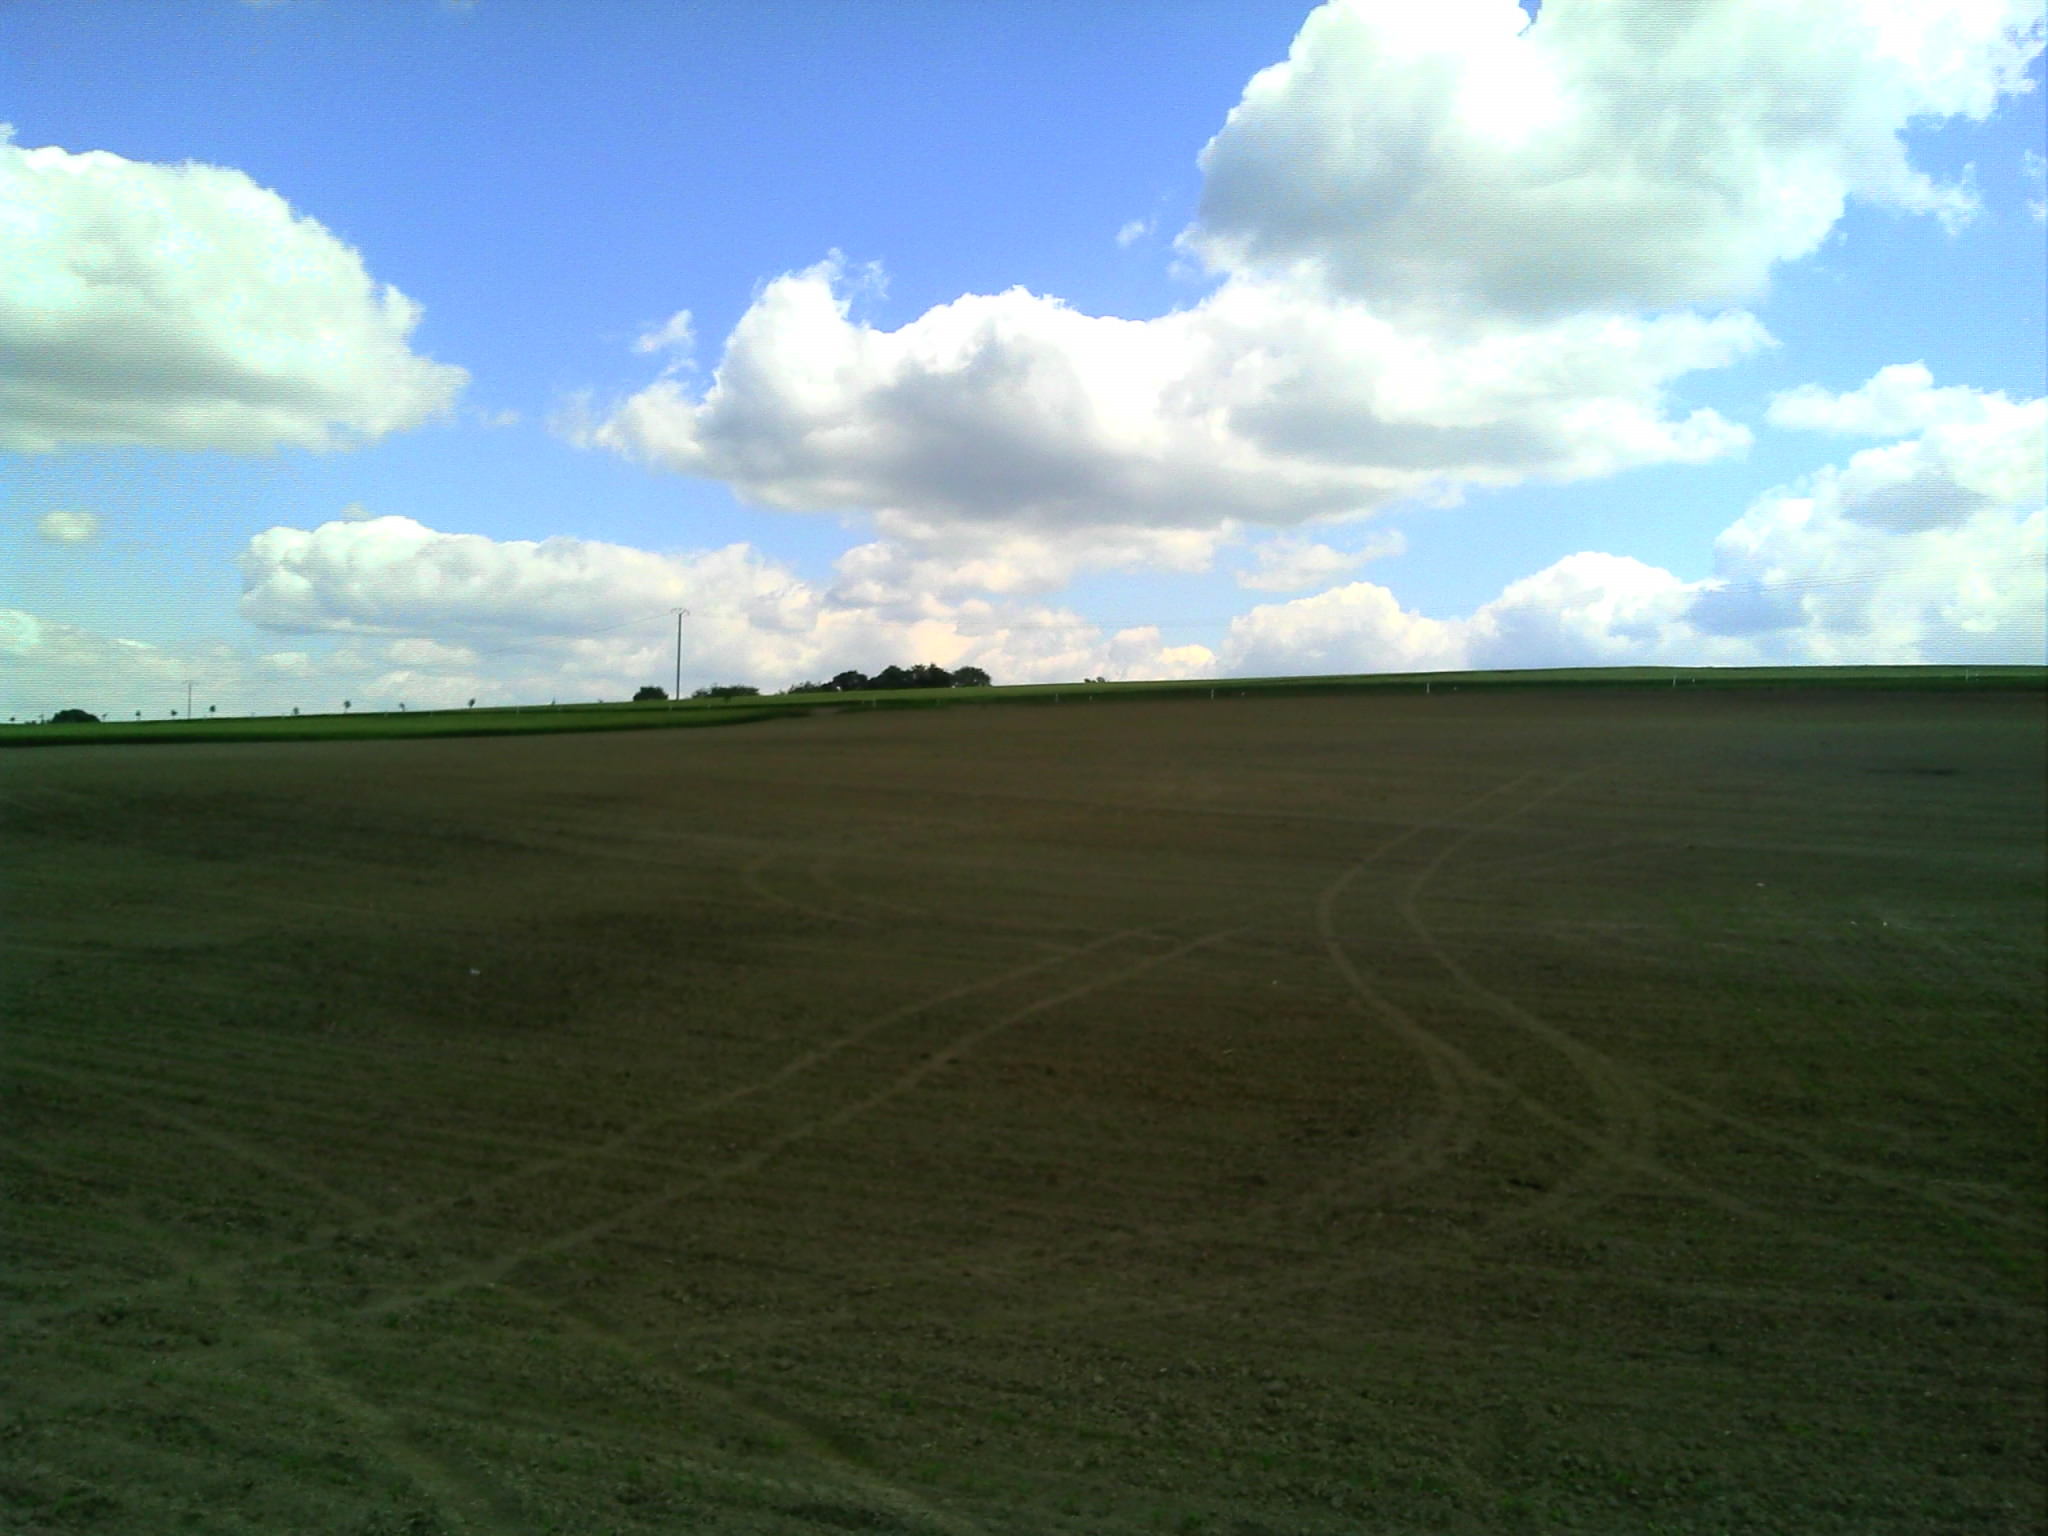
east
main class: Cropland
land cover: Maize
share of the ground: > 75 %
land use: Agriculture (excluding fallow land and kitchen gardens)
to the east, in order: Maize; Grass margins; Paved roads, cycling and walking lanes; Grass margins; Electric lines; Barley
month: May
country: LU
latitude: 49.5844
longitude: 6.3065
